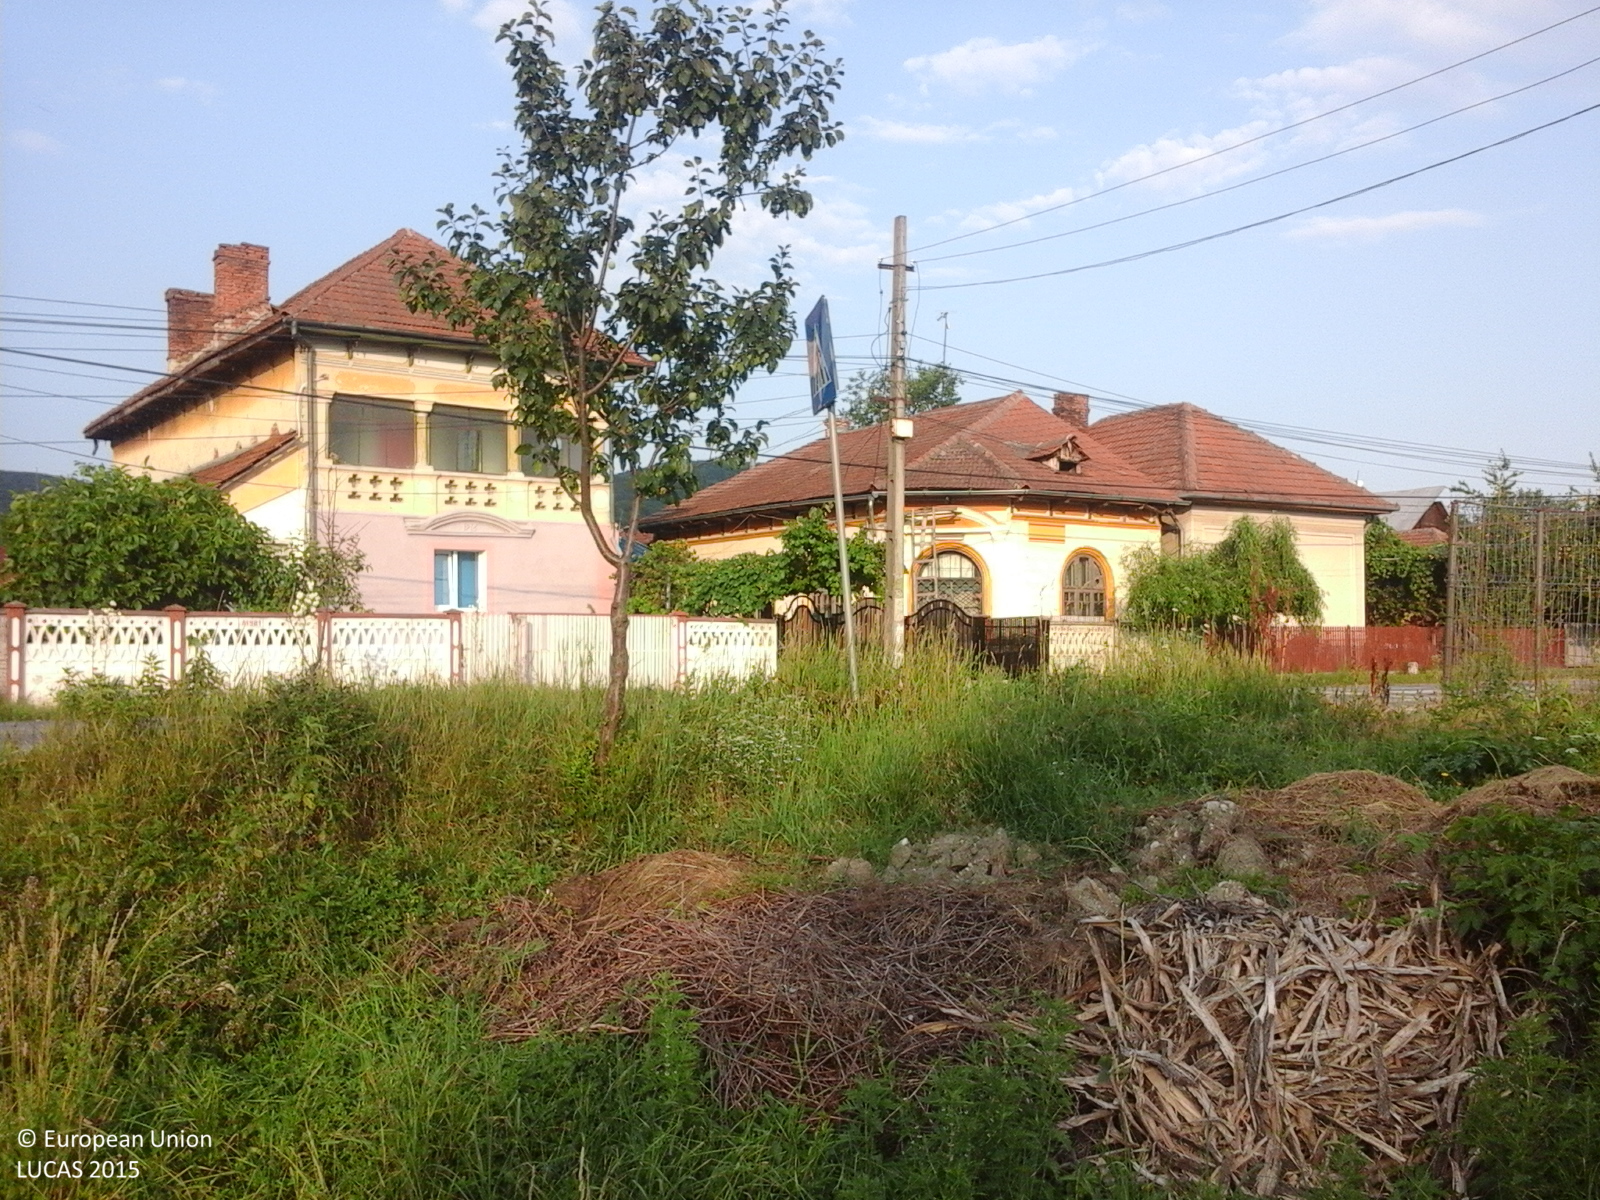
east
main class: Grassland
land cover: Grassland without tree/shrub cover
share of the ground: > 75 %
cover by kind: herbaceous plants 100 %
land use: Agriculture (excluding fallow land and kitchen gardens)
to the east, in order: Grassland without tree/shrub cover; Electric lines; Grassland without tree/shrub cover; Artificial constructions in urban areas; Permanent crops (only in case pi); Arable land (only in case pi); Lines of trees; Fences; Grassland without tree/shrub cover; Lines of trees; Maize; Grassland without tree/shrub cover; Fences
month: July
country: RO
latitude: 45.0549
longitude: 24.6952
